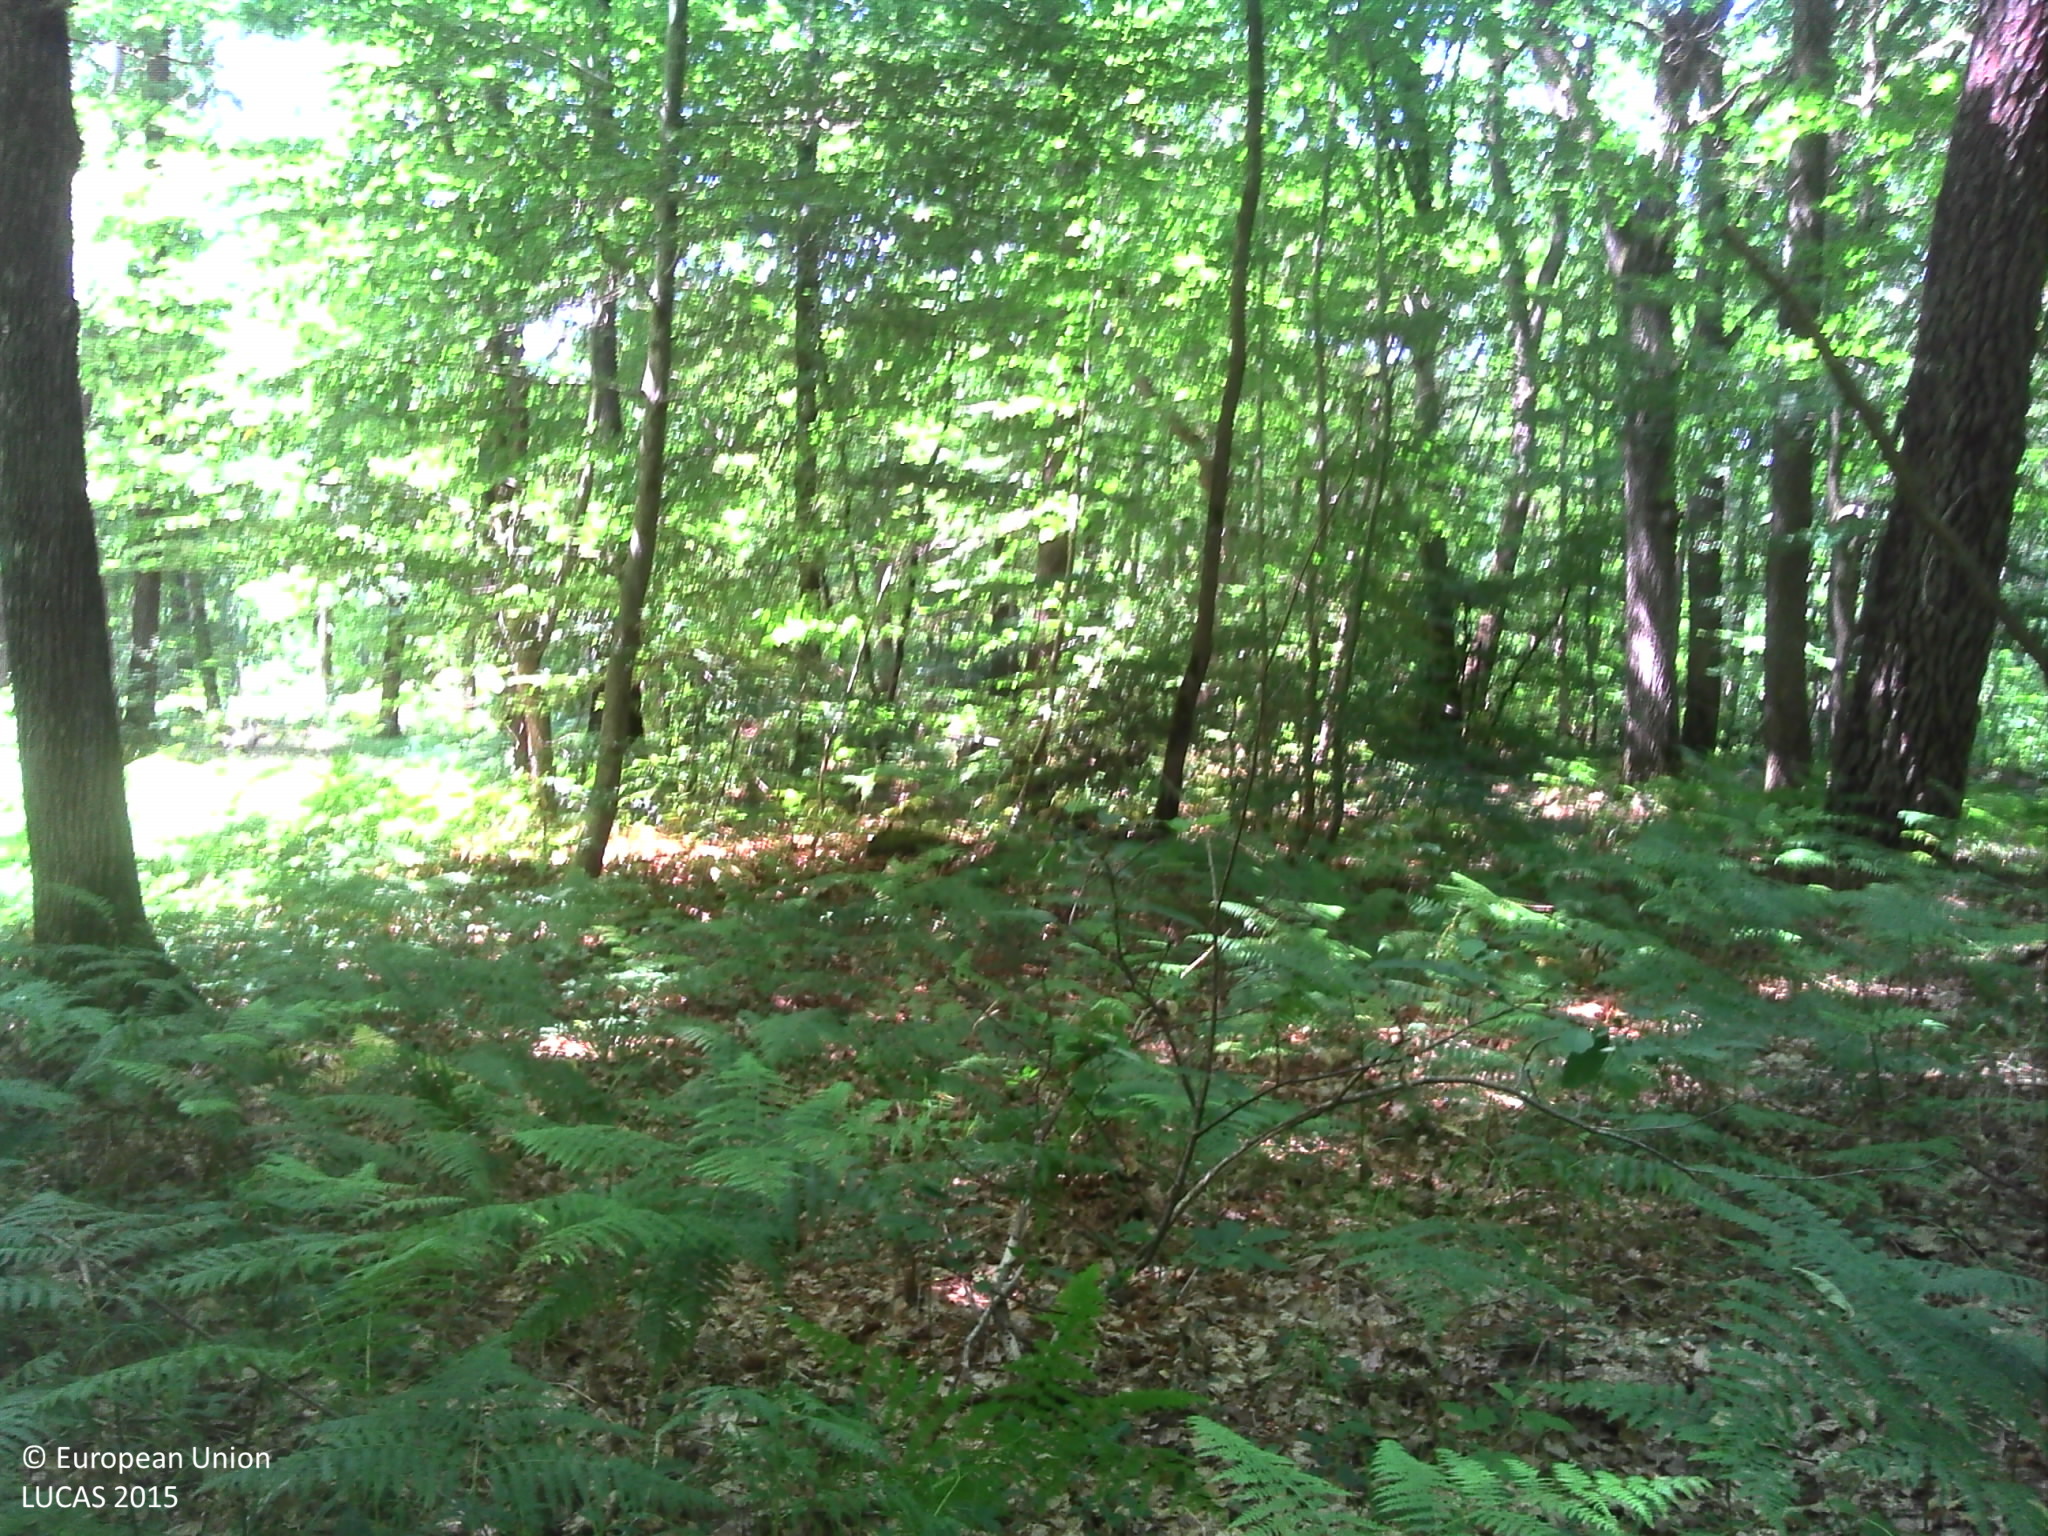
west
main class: Woodland
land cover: Broadleaved woodland
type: mesophytic deciduous forest
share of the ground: > 75 %
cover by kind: broadleaved forest trees 80 %, herbaceous plants 10 %, coniferous forest trees 5 %, lichens and mosses 5 %
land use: Forestry
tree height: > 5 m
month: June
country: FR
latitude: 47.5474
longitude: 0.3706
